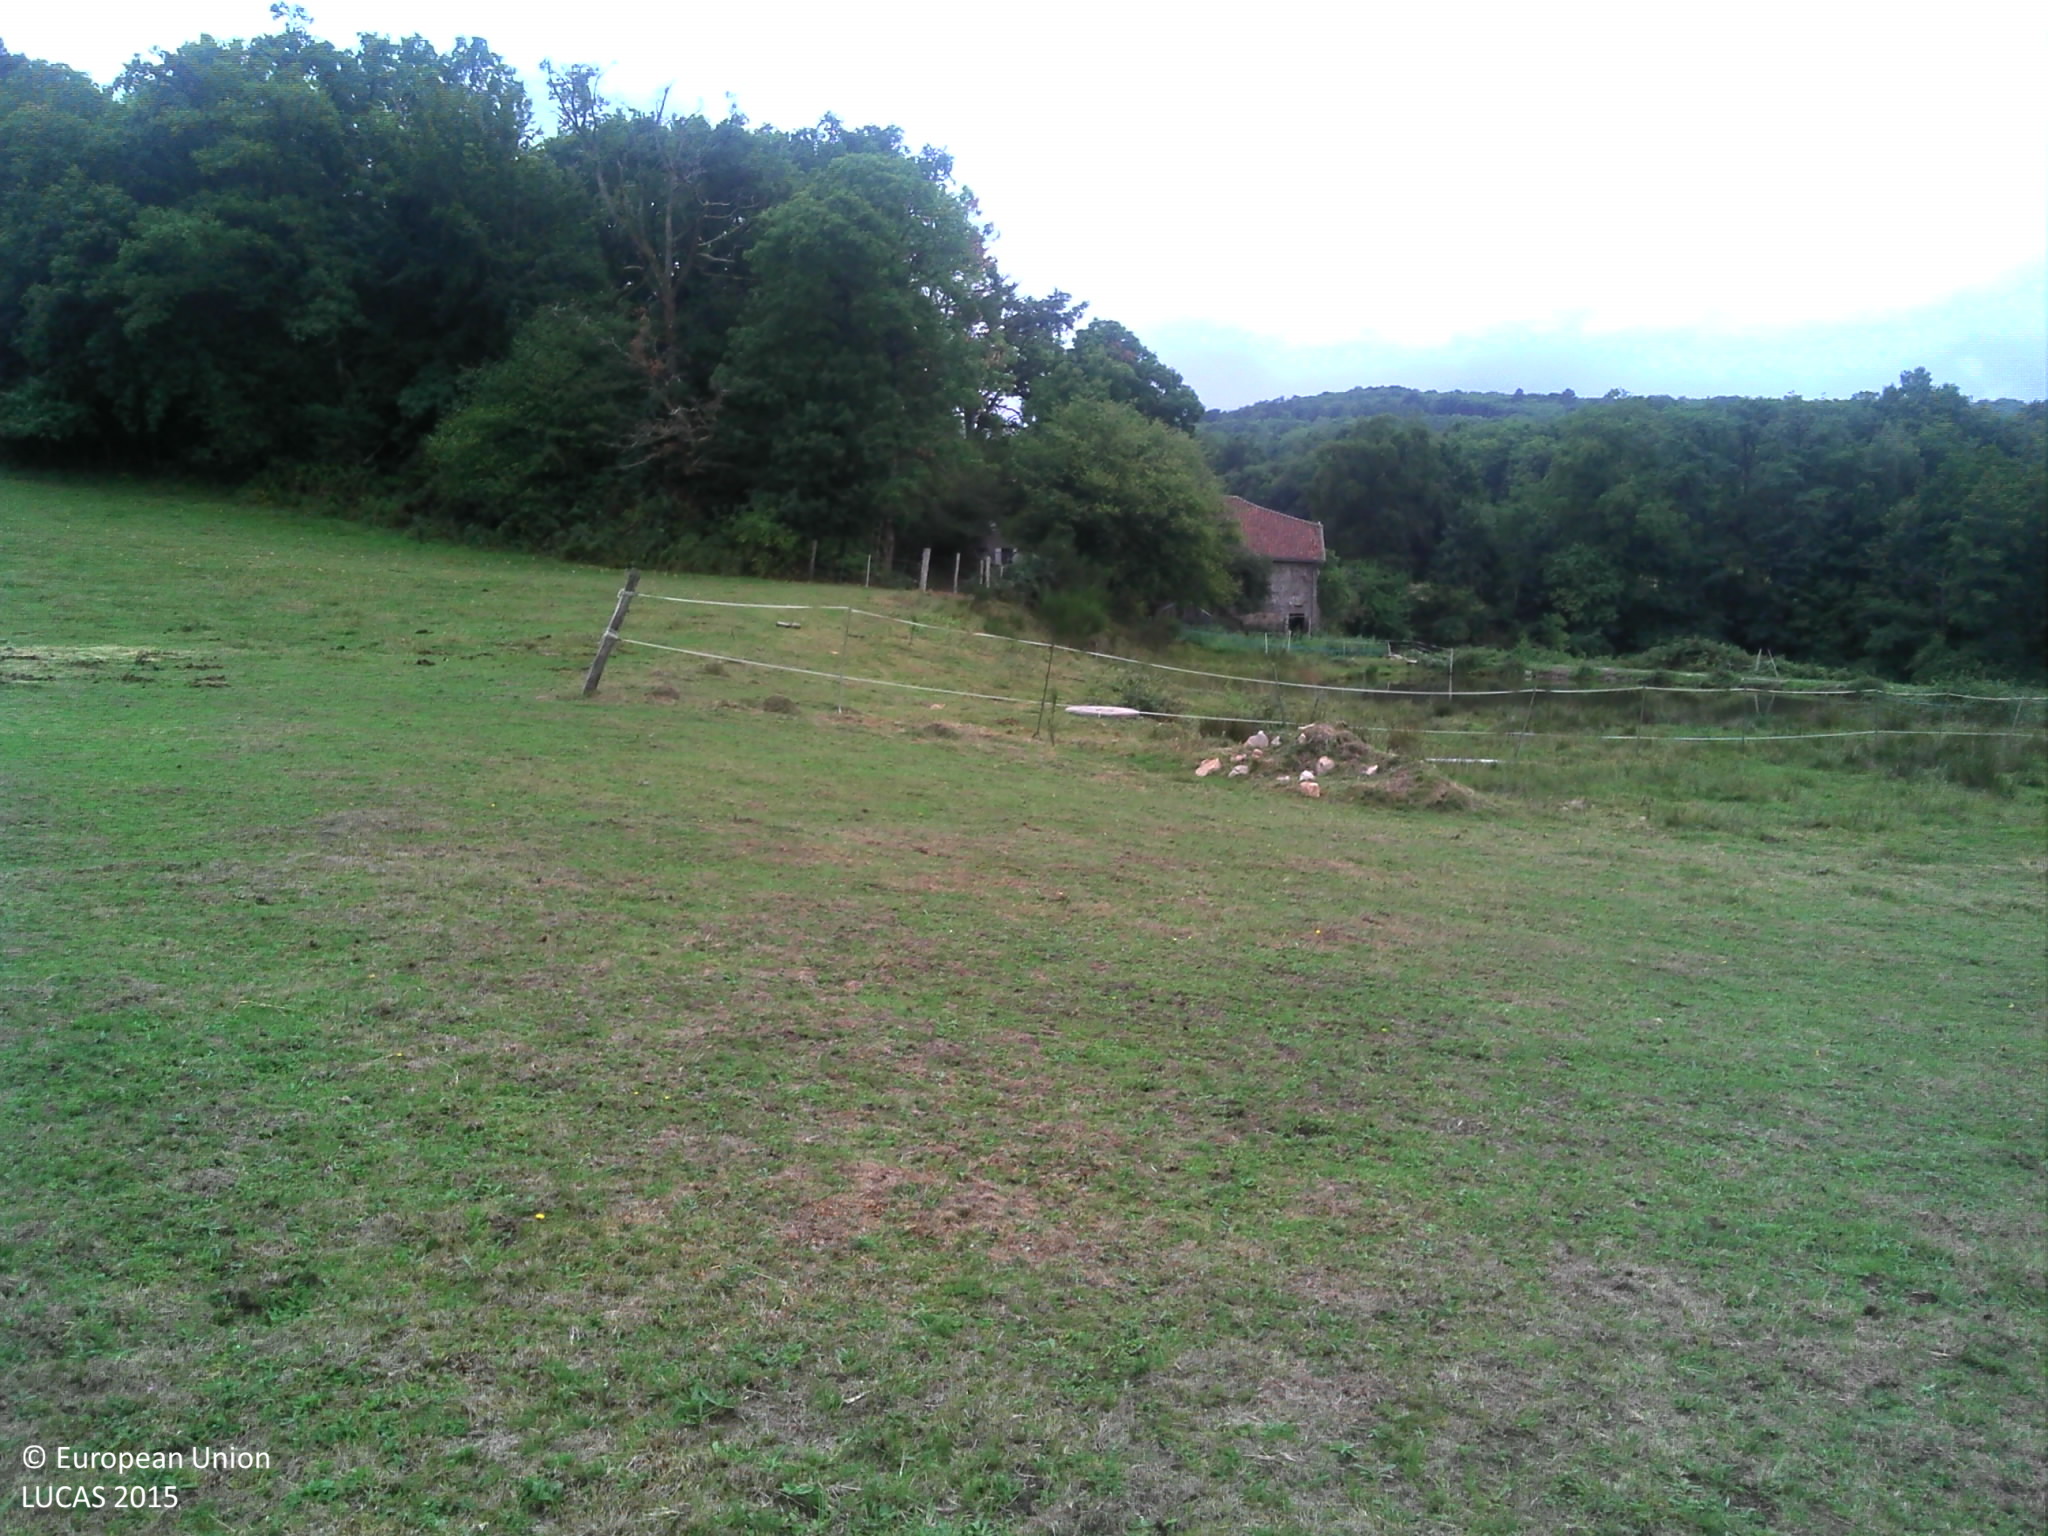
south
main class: Grassland
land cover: Grassland without tree/shrub cover
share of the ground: > 75 %
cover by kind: herbaceous plants 100 %
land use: Agriculture (excluding fallow land and kitchen gardens)
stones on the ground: 10 - 25 %
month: August
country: FR
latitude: 46.0421
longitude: 0.9813
